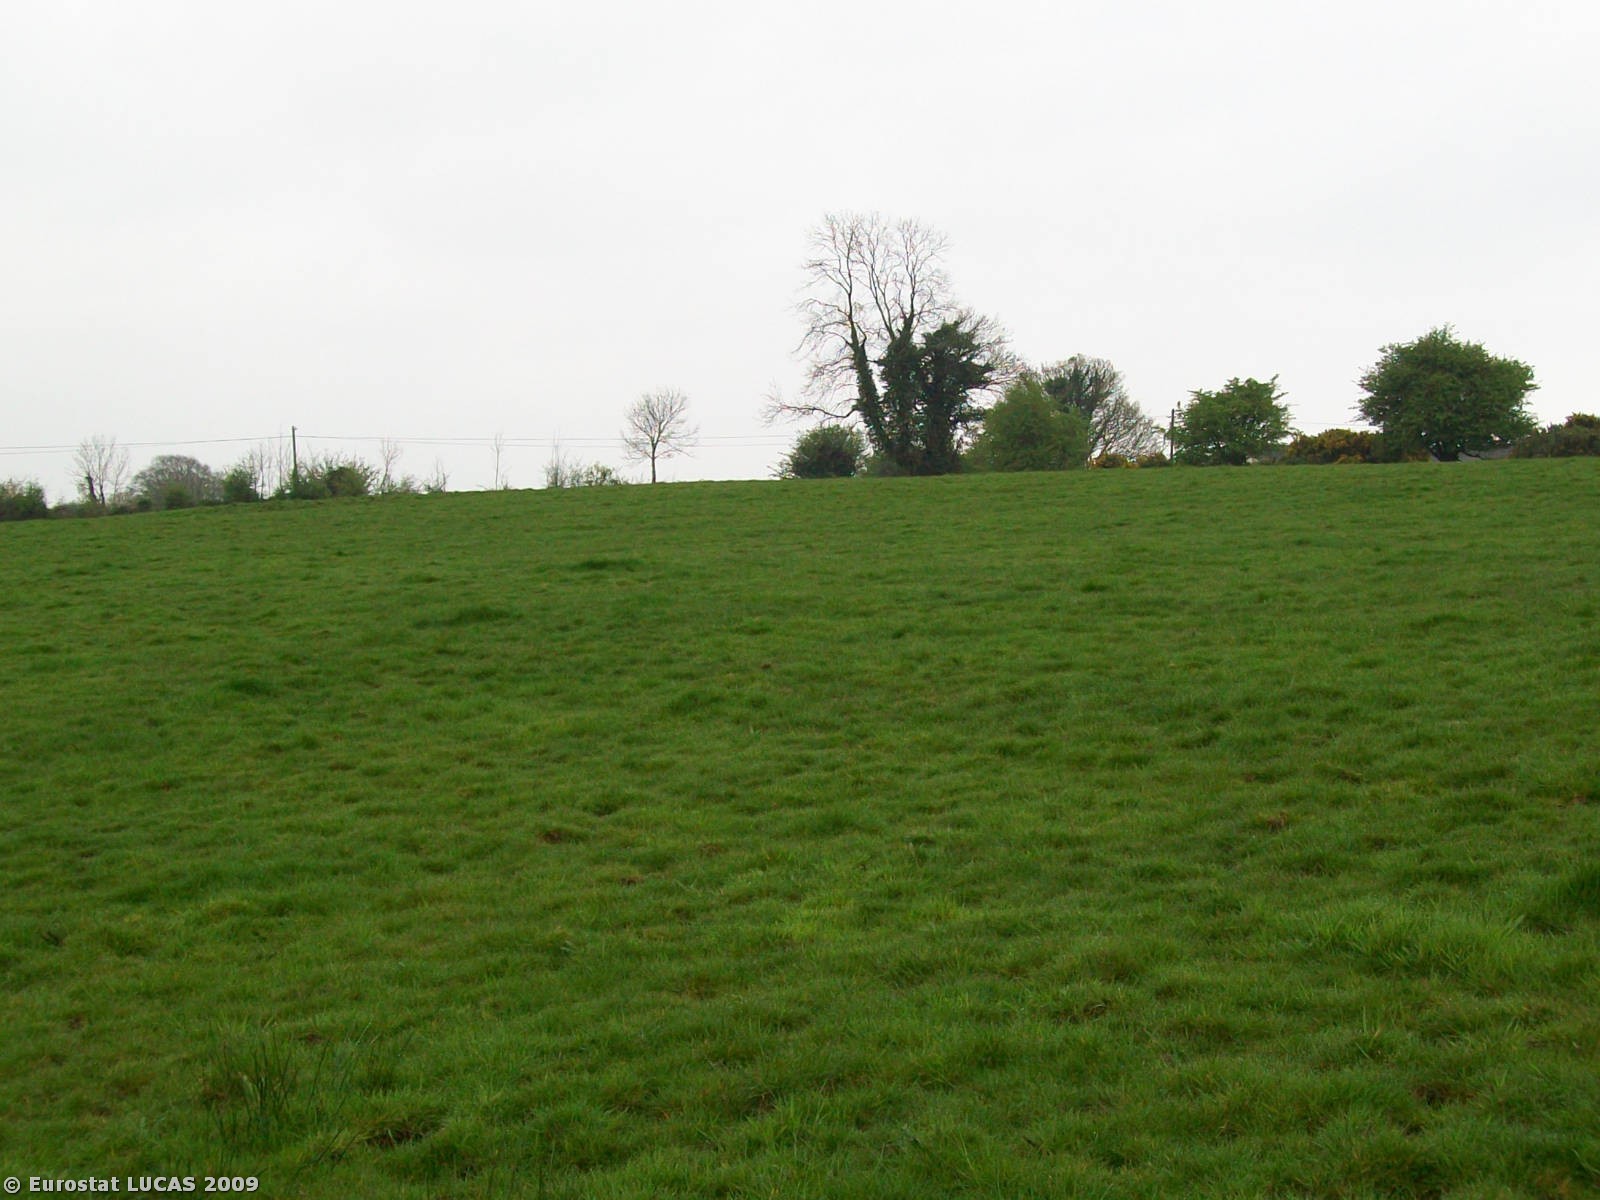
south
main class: Grassland
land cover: Grassland without tree/shrub cover
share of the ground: > 75 %
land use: Agriculture (excluding fallow land and kitchen gardens)
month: April
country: IE
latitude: 53.5839
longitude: -8.1402
